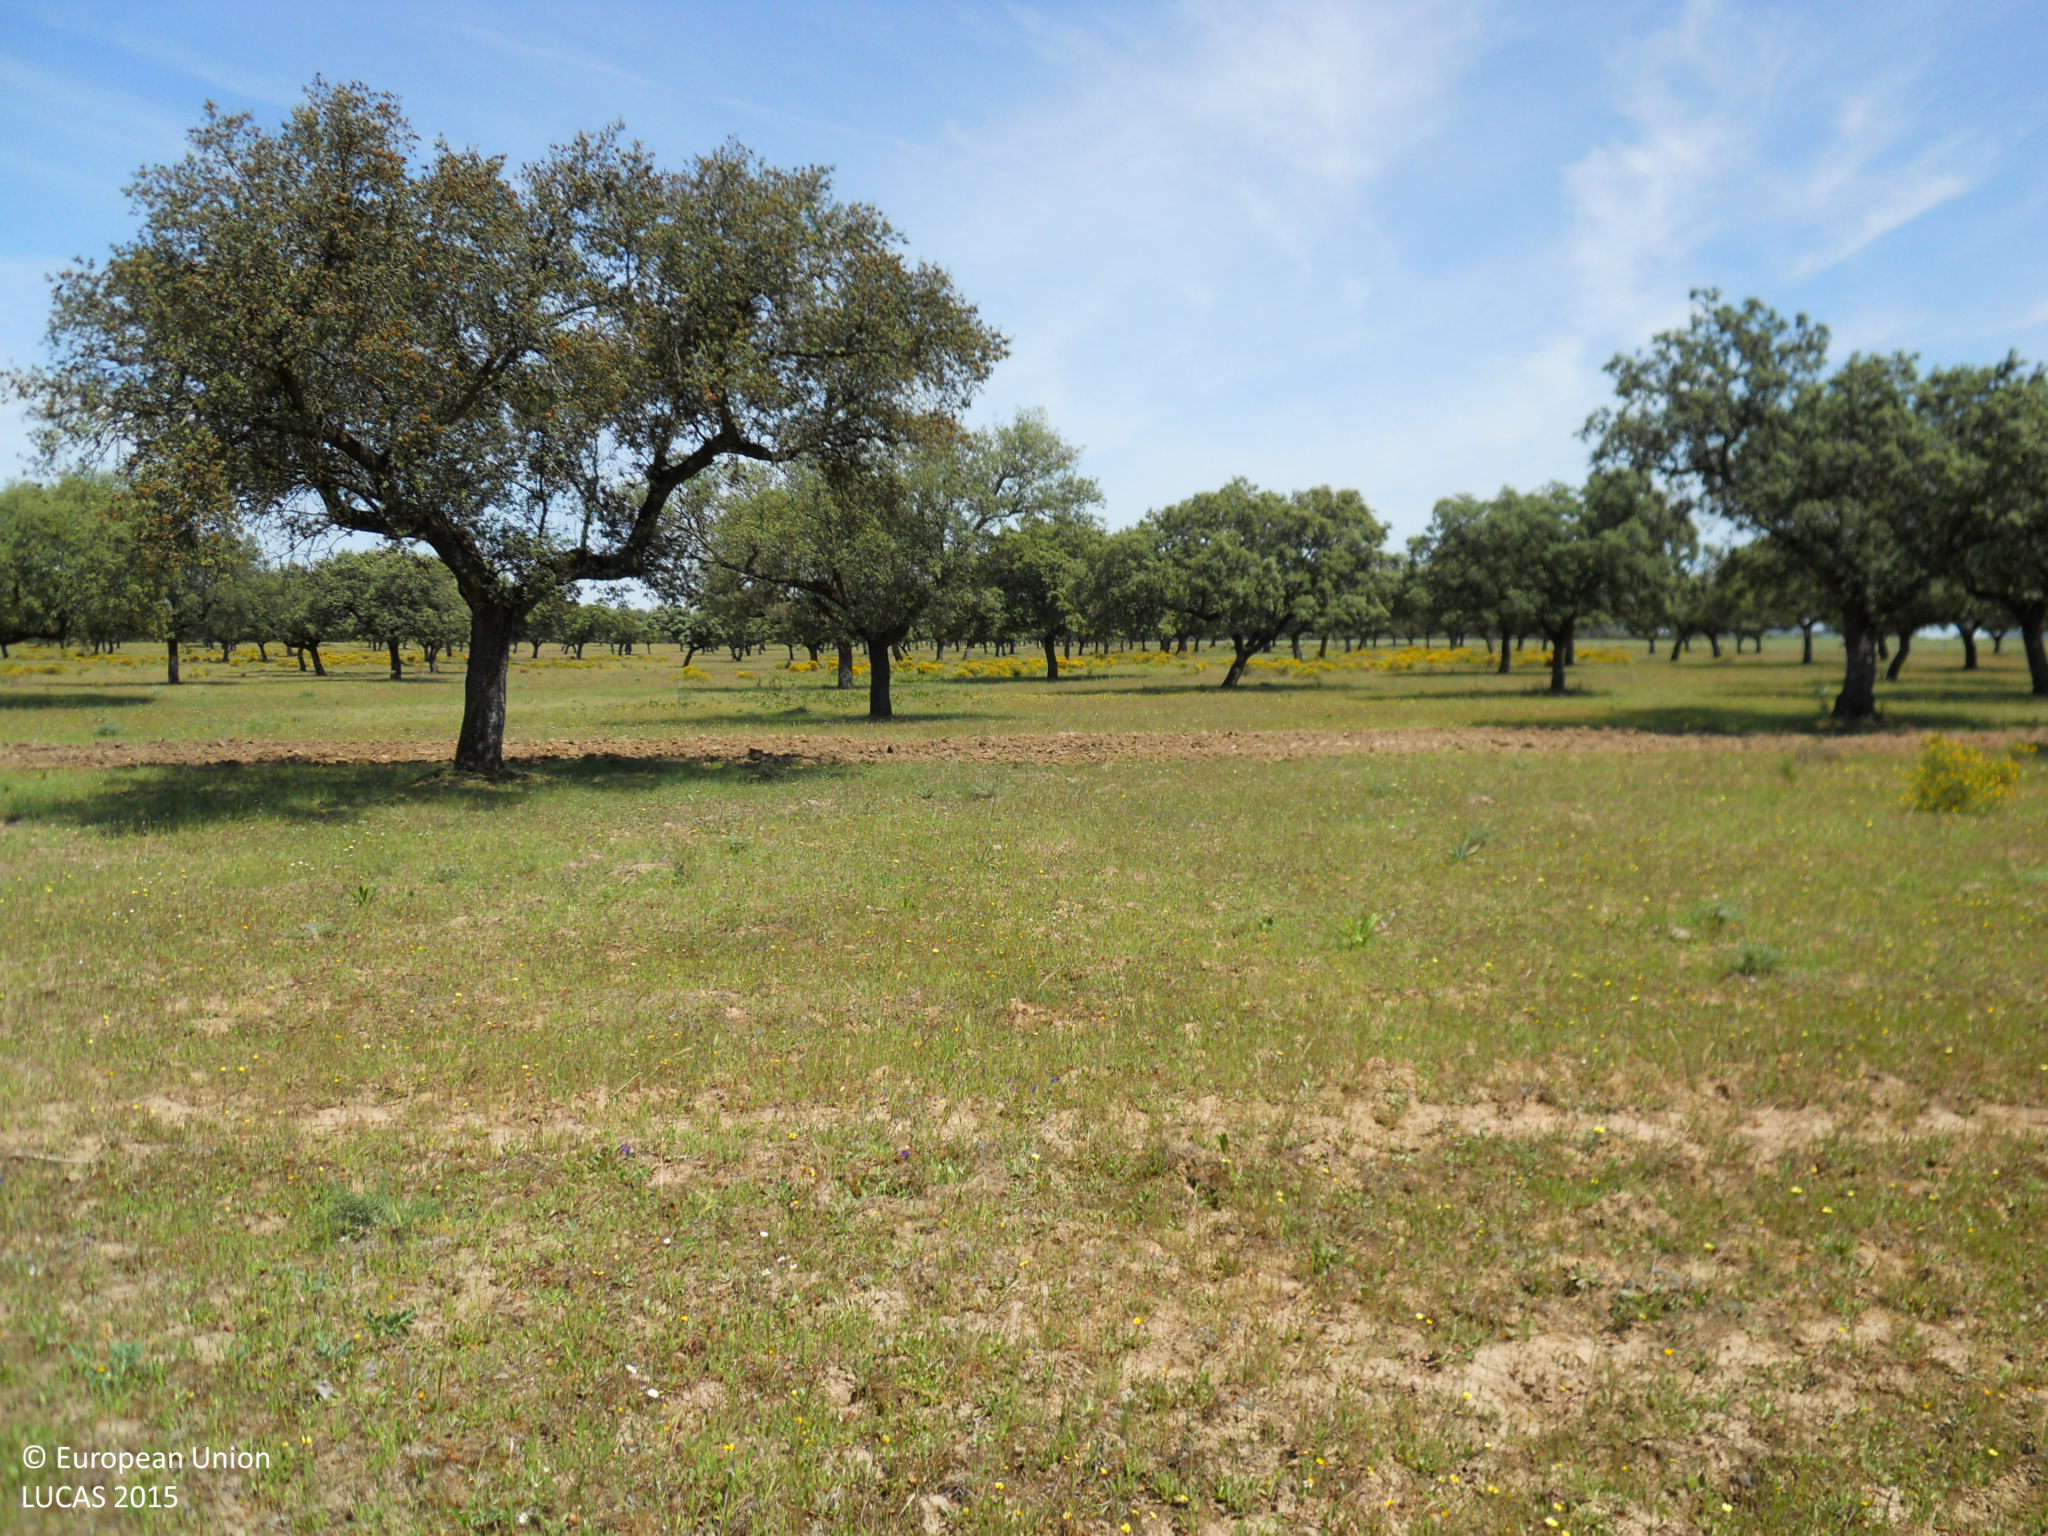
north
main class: Woodland
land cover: Broadleaved woodland
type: broadleaved evergreen forest
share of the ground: 10 - 25 %
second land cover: Grassland without tree/shrub cover
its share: > 75 %
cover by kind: herbaceous plants 80 %, broadleaved forest trees 20 %
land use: Forestry
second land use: Agriculture (excluding fallow land and kitchen gardens)
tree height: > 5 m
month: April
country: ES
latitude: 39.0896
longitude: -6.8701
